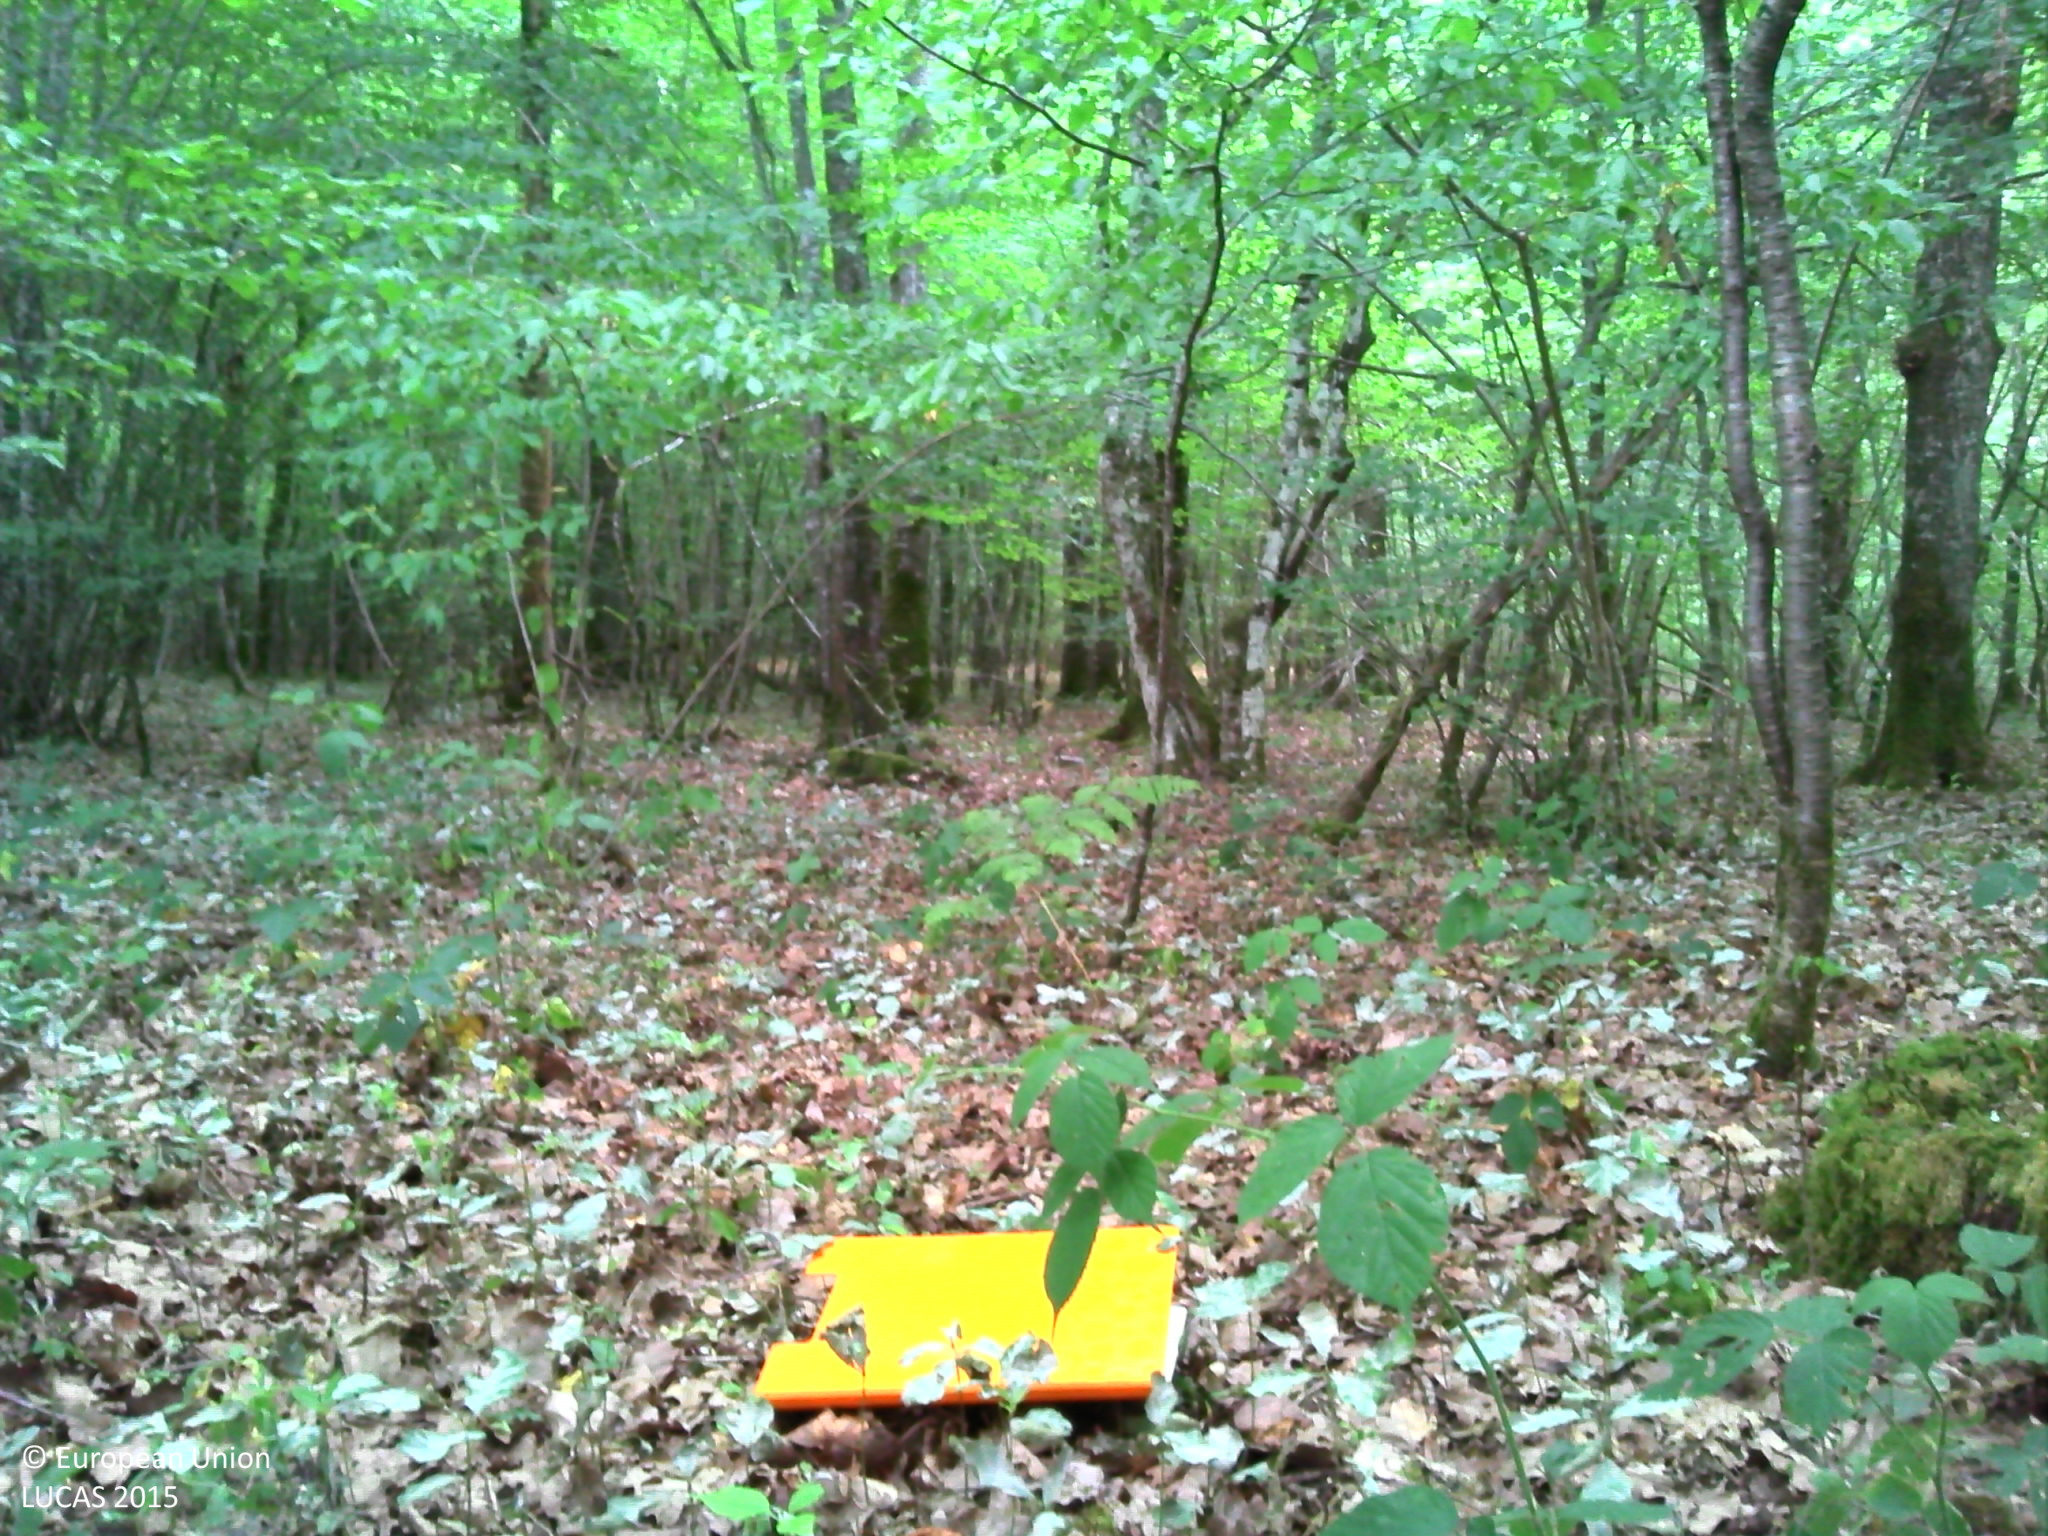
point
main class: Woodland
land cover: Broadleaved woodland
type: mesophytic deciduous forest
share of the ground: > 75 %
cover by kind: broadleaved forest trees 100 %
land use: Forestry
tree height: > 5 m
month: July
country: FR
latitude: 46.7363
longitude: 3.2838
